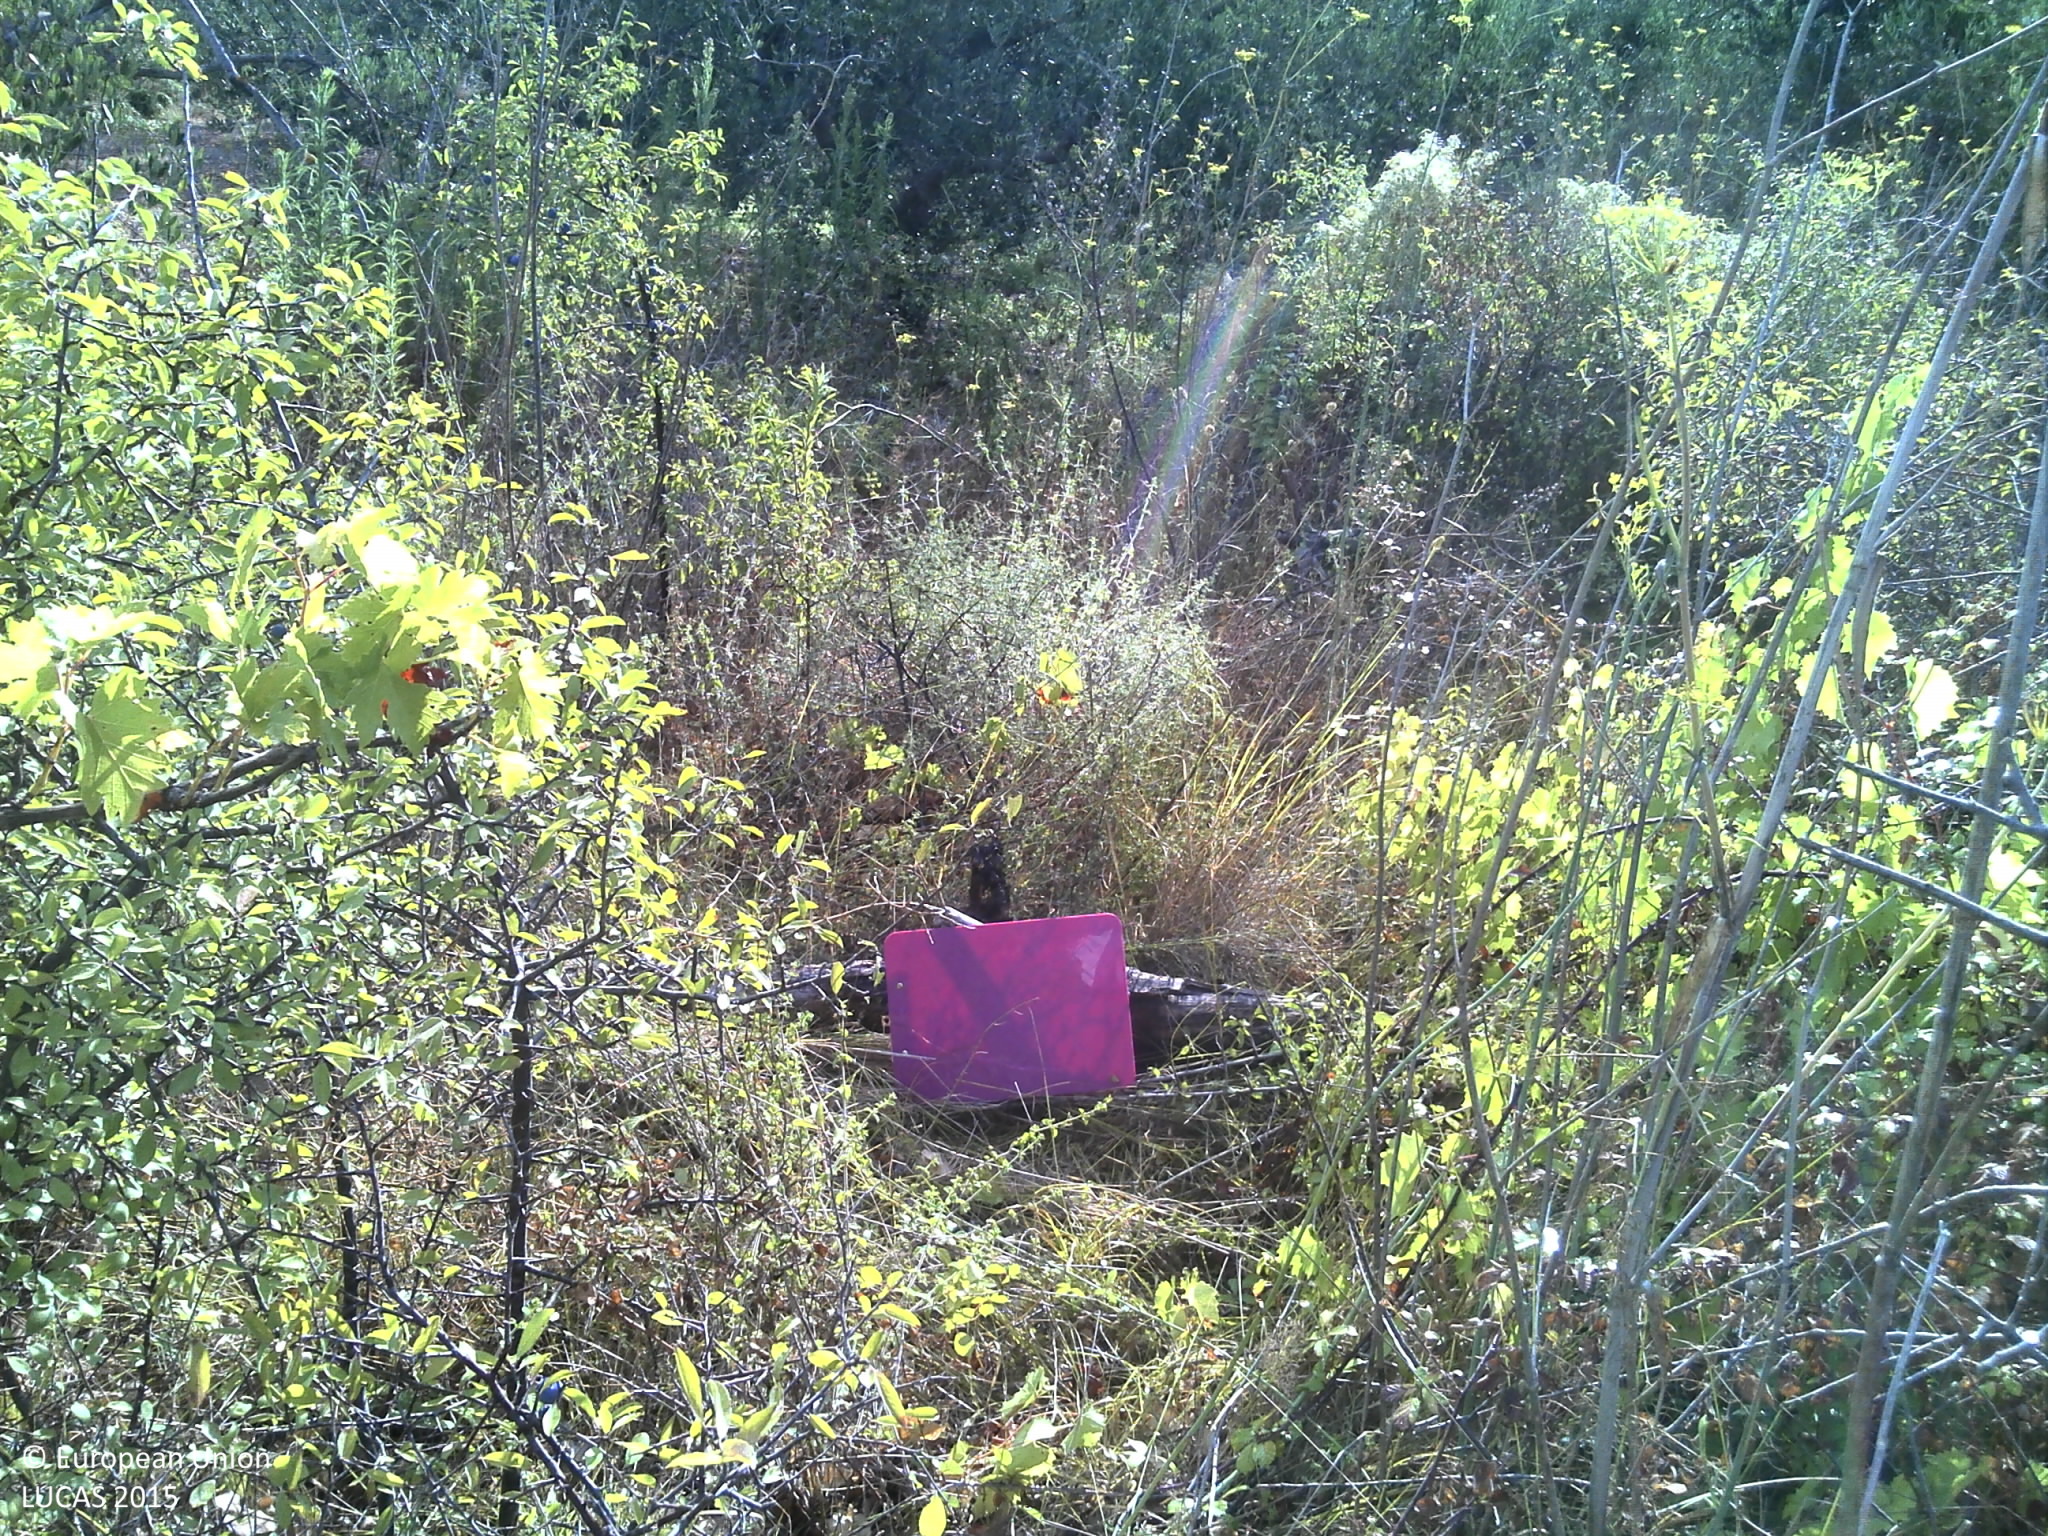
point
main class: Shrubland
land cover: Shrubland with sparse tree cover
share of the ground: > 75 %
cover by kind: shrubs 70 %, herbaceous plants 15 %, broadleaved forest trees 5 %, consolidated bare surface 5 %, unconsolidated bare surface 5 %
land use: Semi-natural and natural areas not in use
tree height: < 5 m
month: August
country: HR
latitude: 43.3603
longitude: 16.3447
